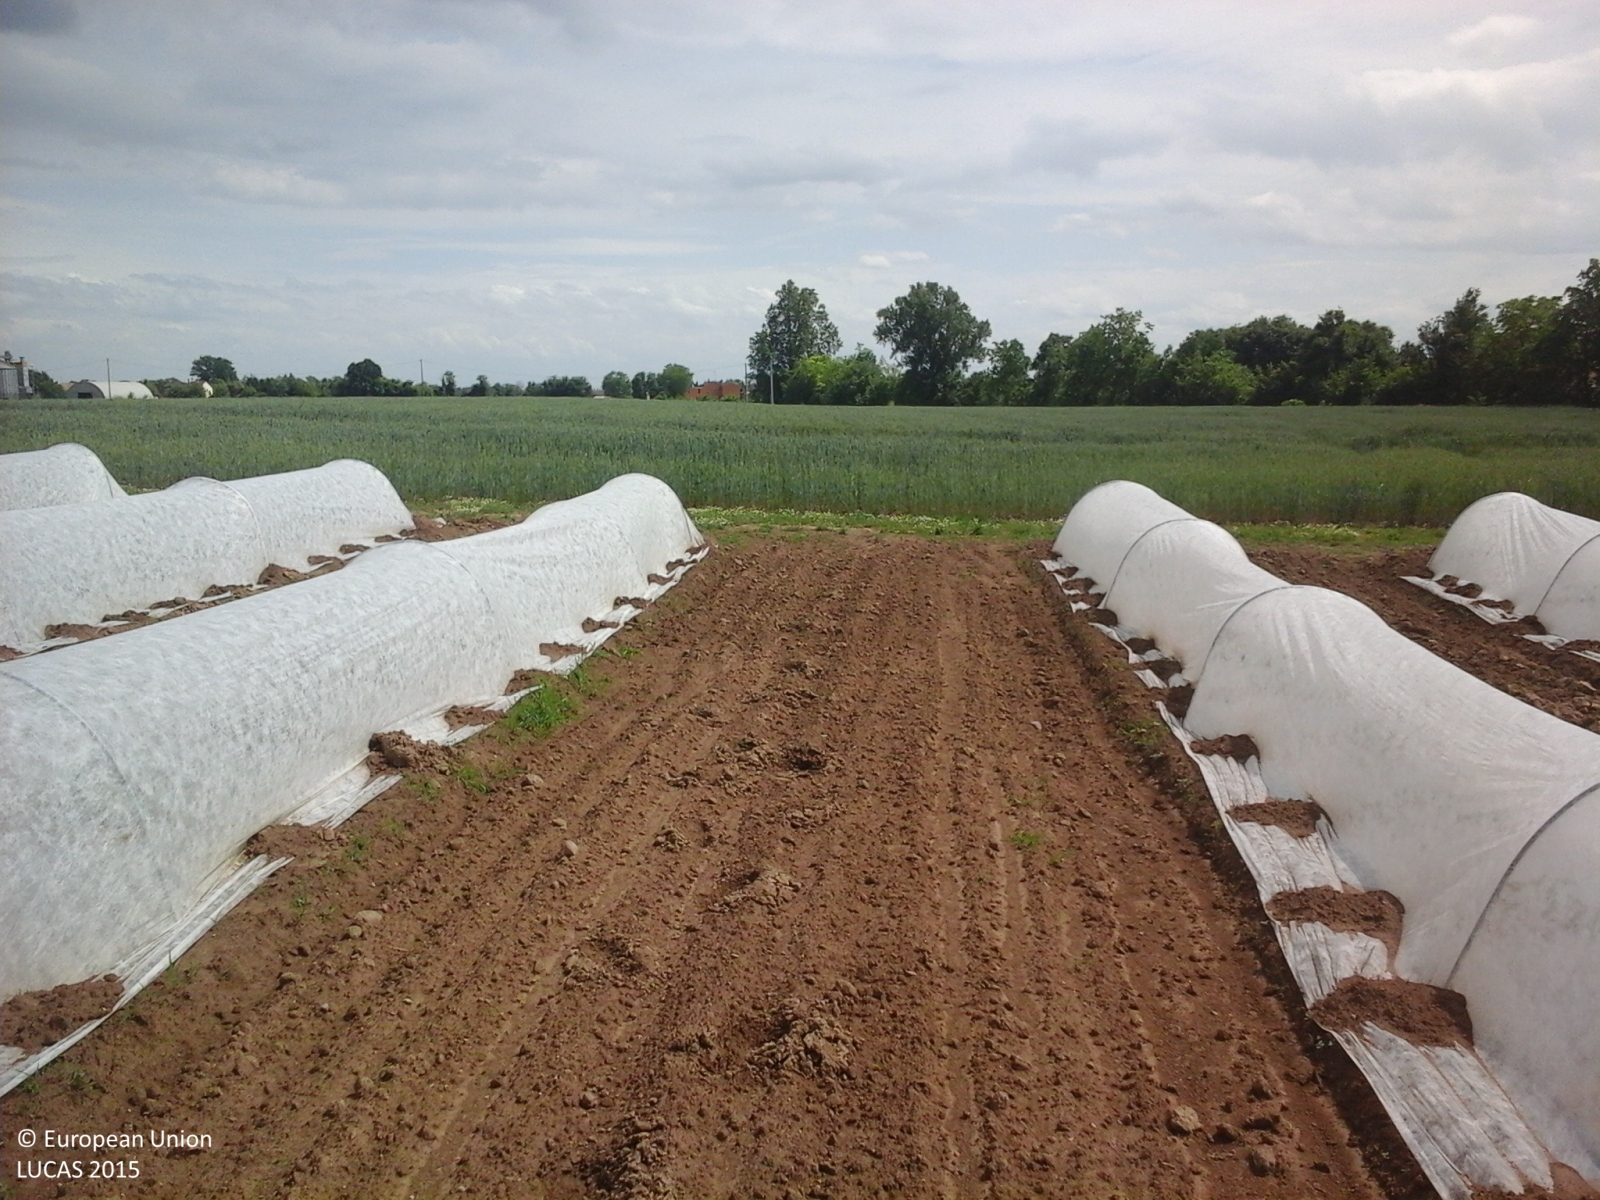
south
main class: Cropland
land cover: Other fresh vegetables
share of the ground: < 10 %
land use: Agriculture (excluding fallow land and kitchen gardens)
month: May
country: IT
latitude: 45.0875
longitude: 10.6974
